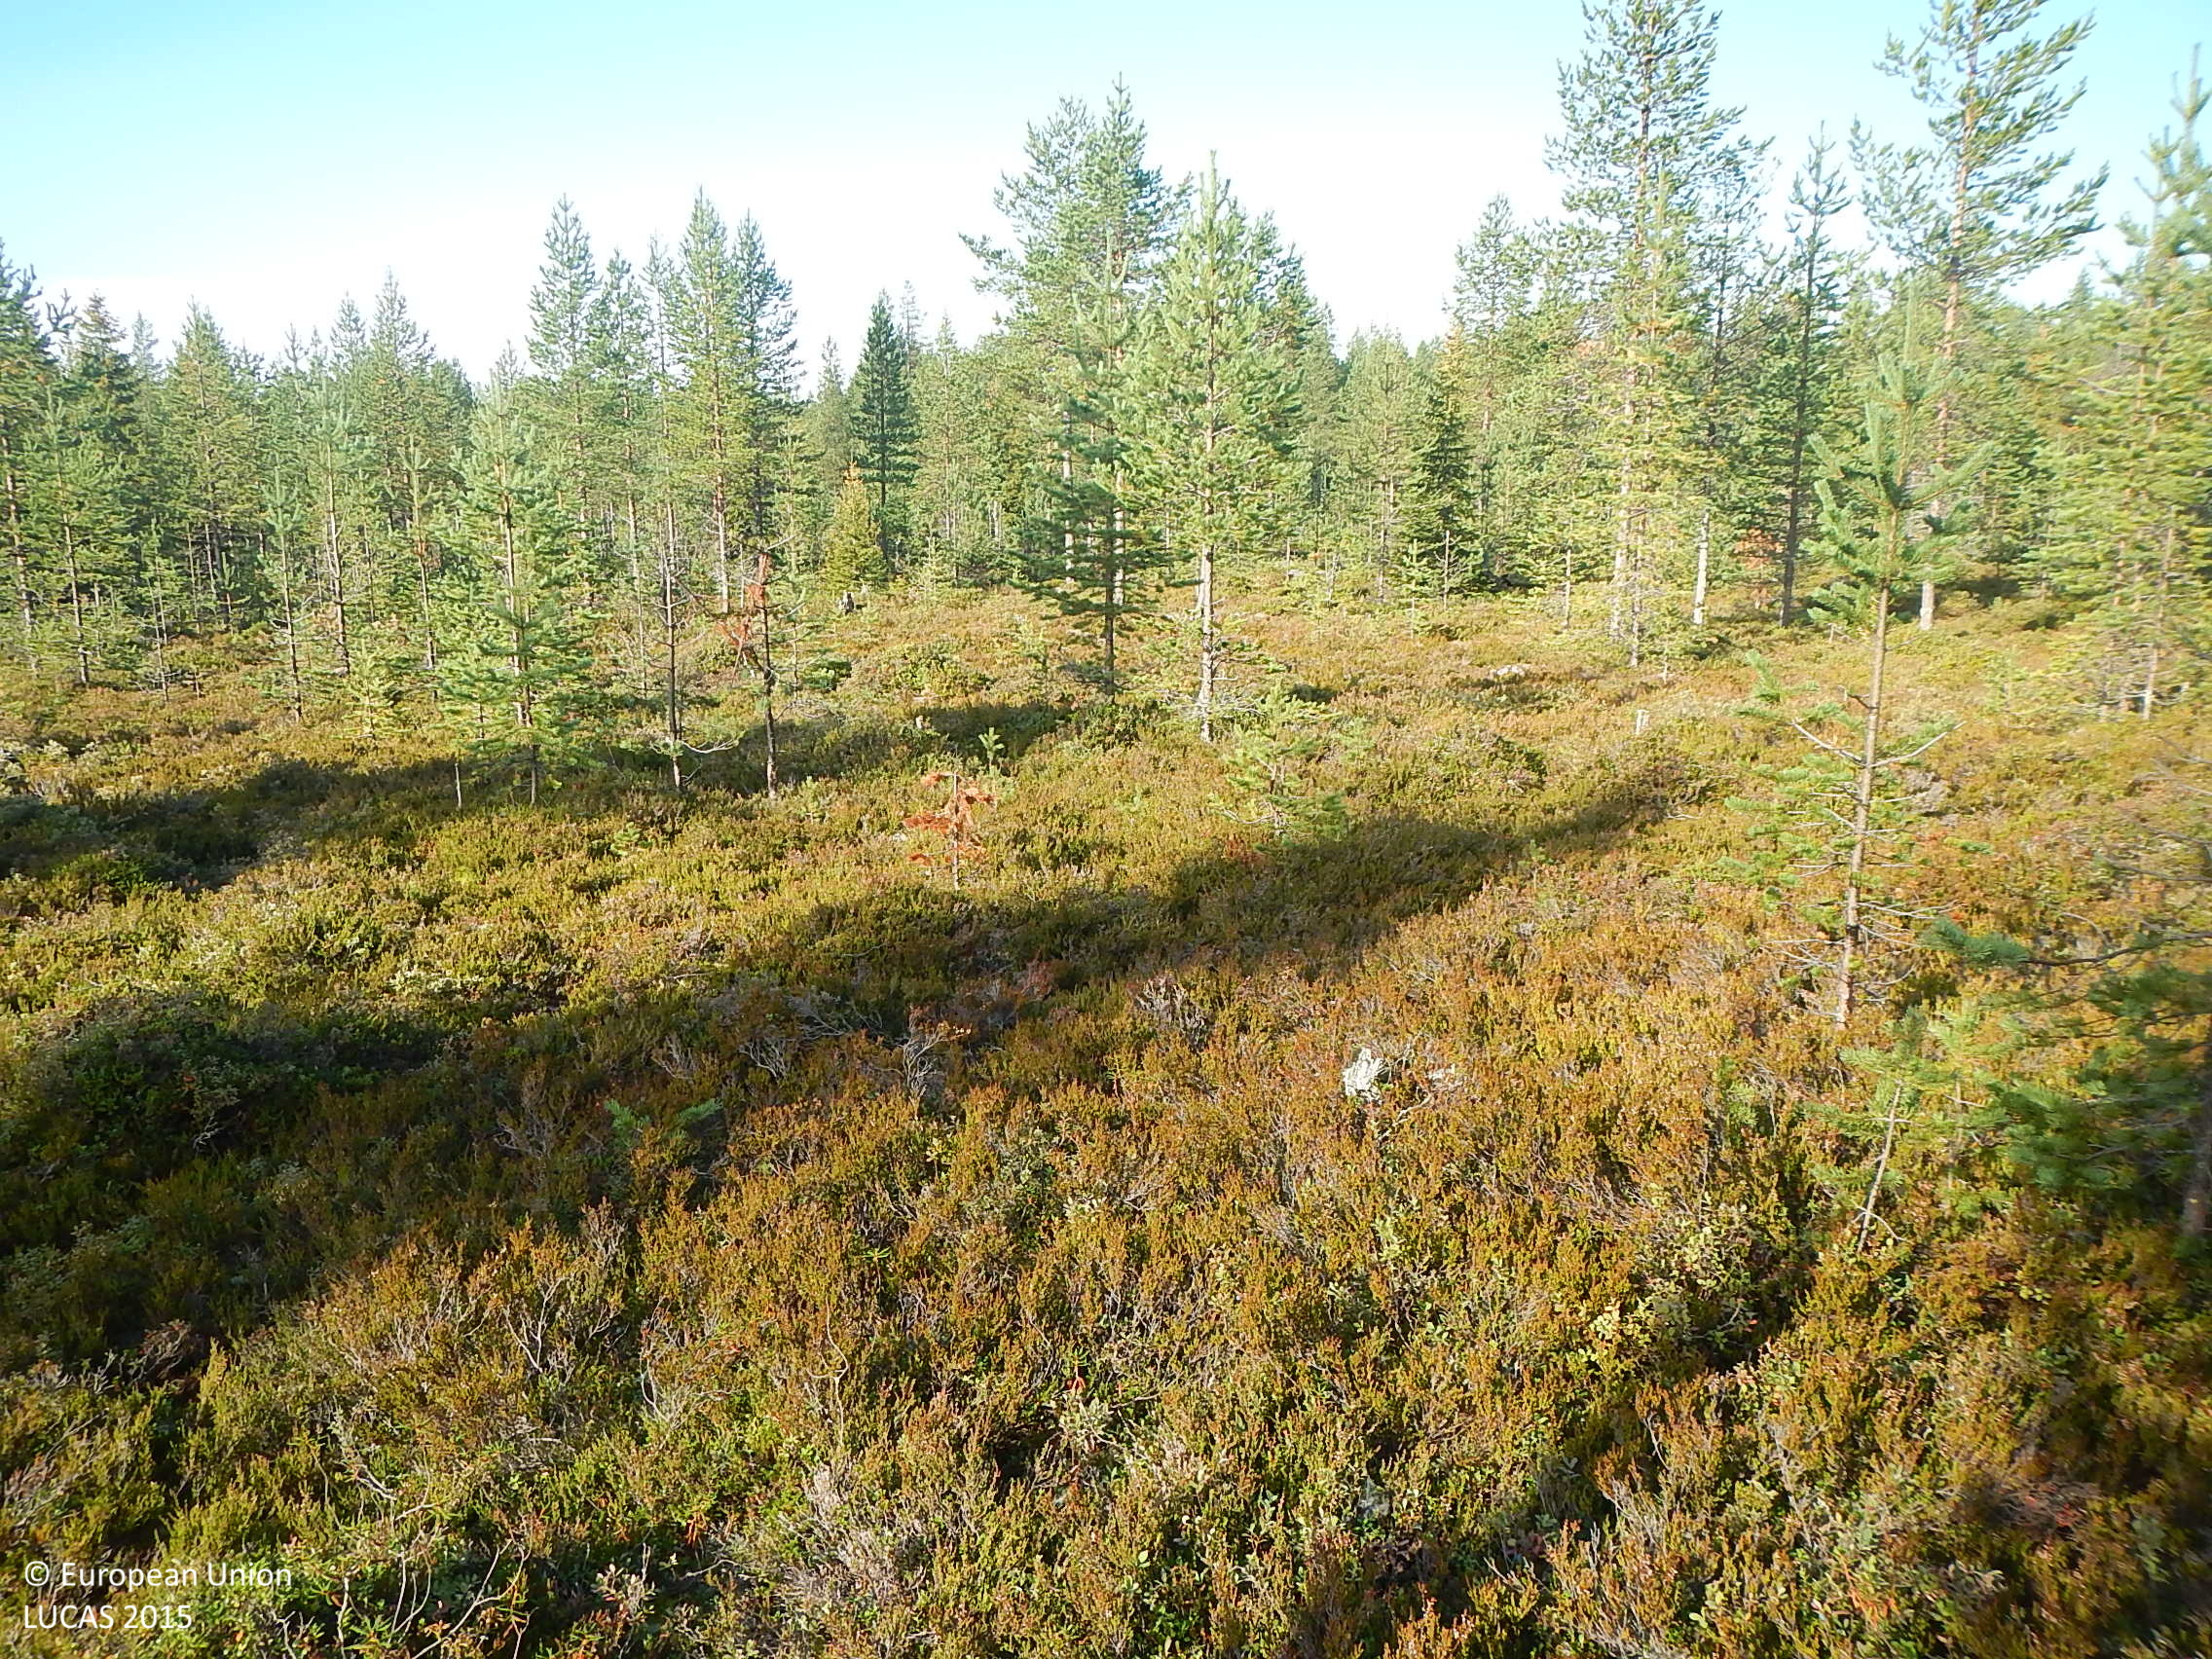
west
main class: Woodland
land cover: Pine dominated coniferous woodland
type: boreal forest
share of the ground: 10 - 25 %
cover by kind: shrubs 80 %, coniferous forest trees 20 %
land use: Forestry
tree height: < 5 m
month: August
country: FI
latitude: 65.4626
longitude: 26.9687
